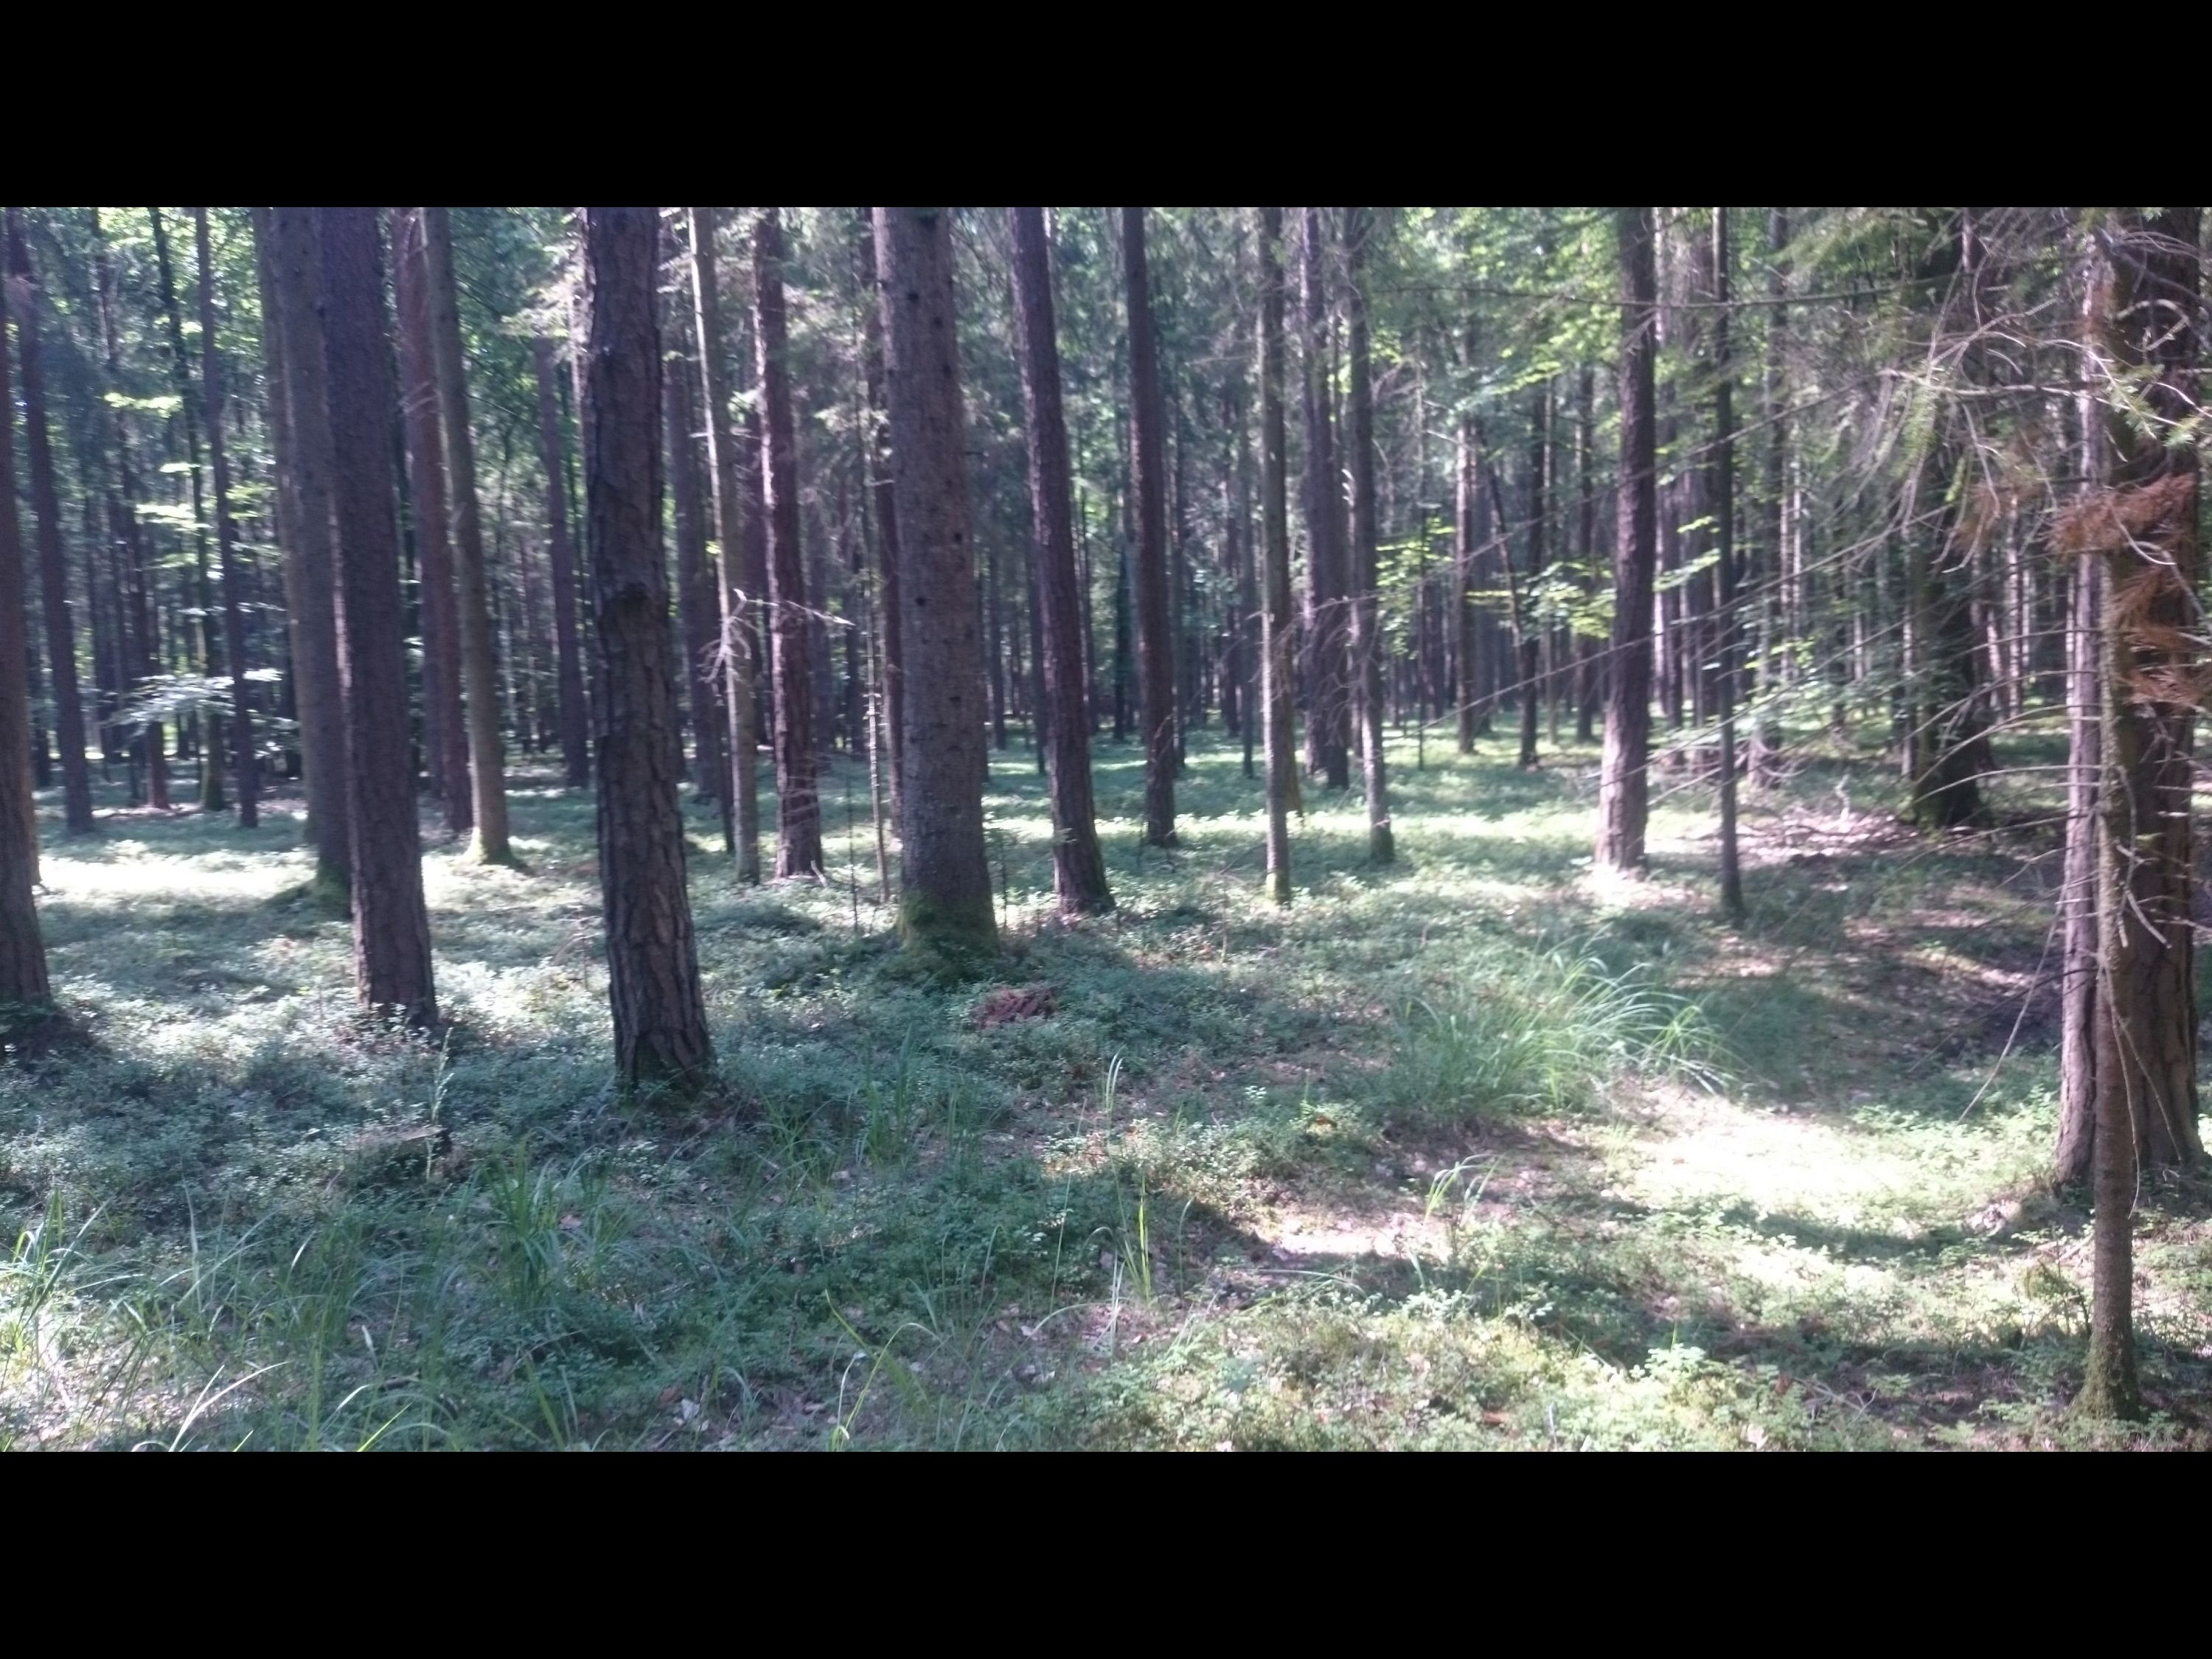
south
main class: Woodland
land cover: Pine dominated coniferous woodland
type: hemiboreal forest and nemoral coniferous forest and mixed broadleaved-coniferous forest
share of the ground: > 75 %
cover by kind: coniferous forest trees 80 %, shrubs 10 %, herbaceous plants 10 %
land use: Forestry
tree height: > 5 m
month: July
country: AT
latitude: 47.1232
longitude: 15.9724
